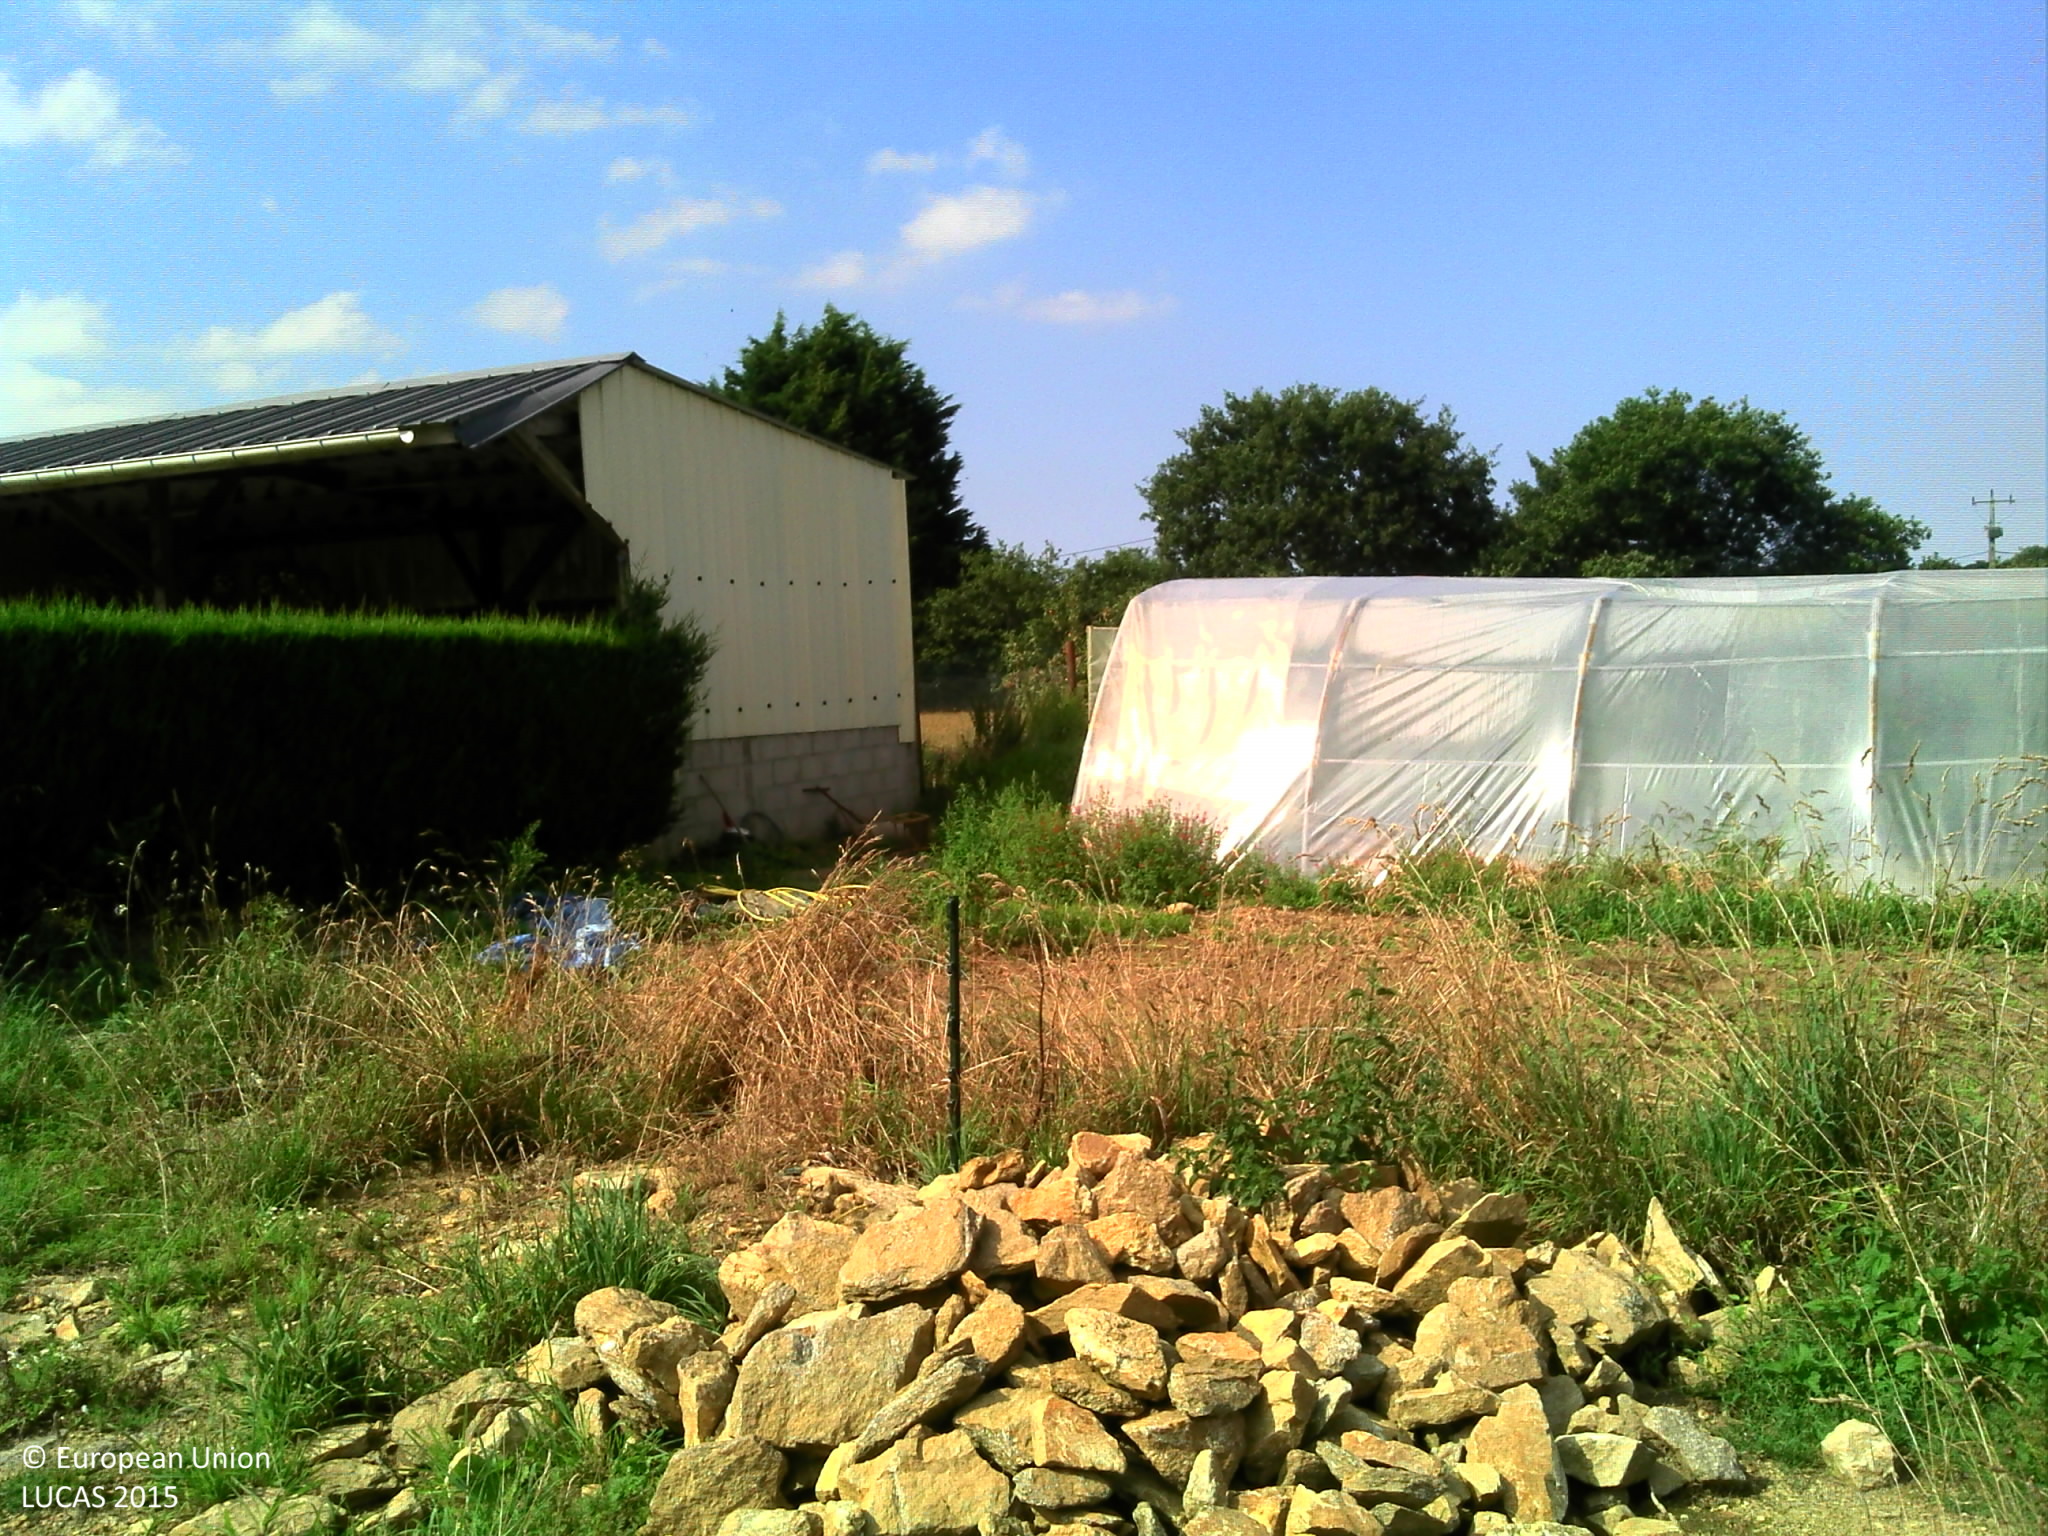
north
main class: Grassland
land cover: Spontaneously vegetated surfaces
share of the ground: 50 - 75 %
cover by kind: herbaceous plants 50 %, unconsolidated bare surface 50 %
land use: Agriculture (excluding fallow land and kitchen gardens)
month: August
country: FR
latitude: 48.6406
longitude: -3.2527
